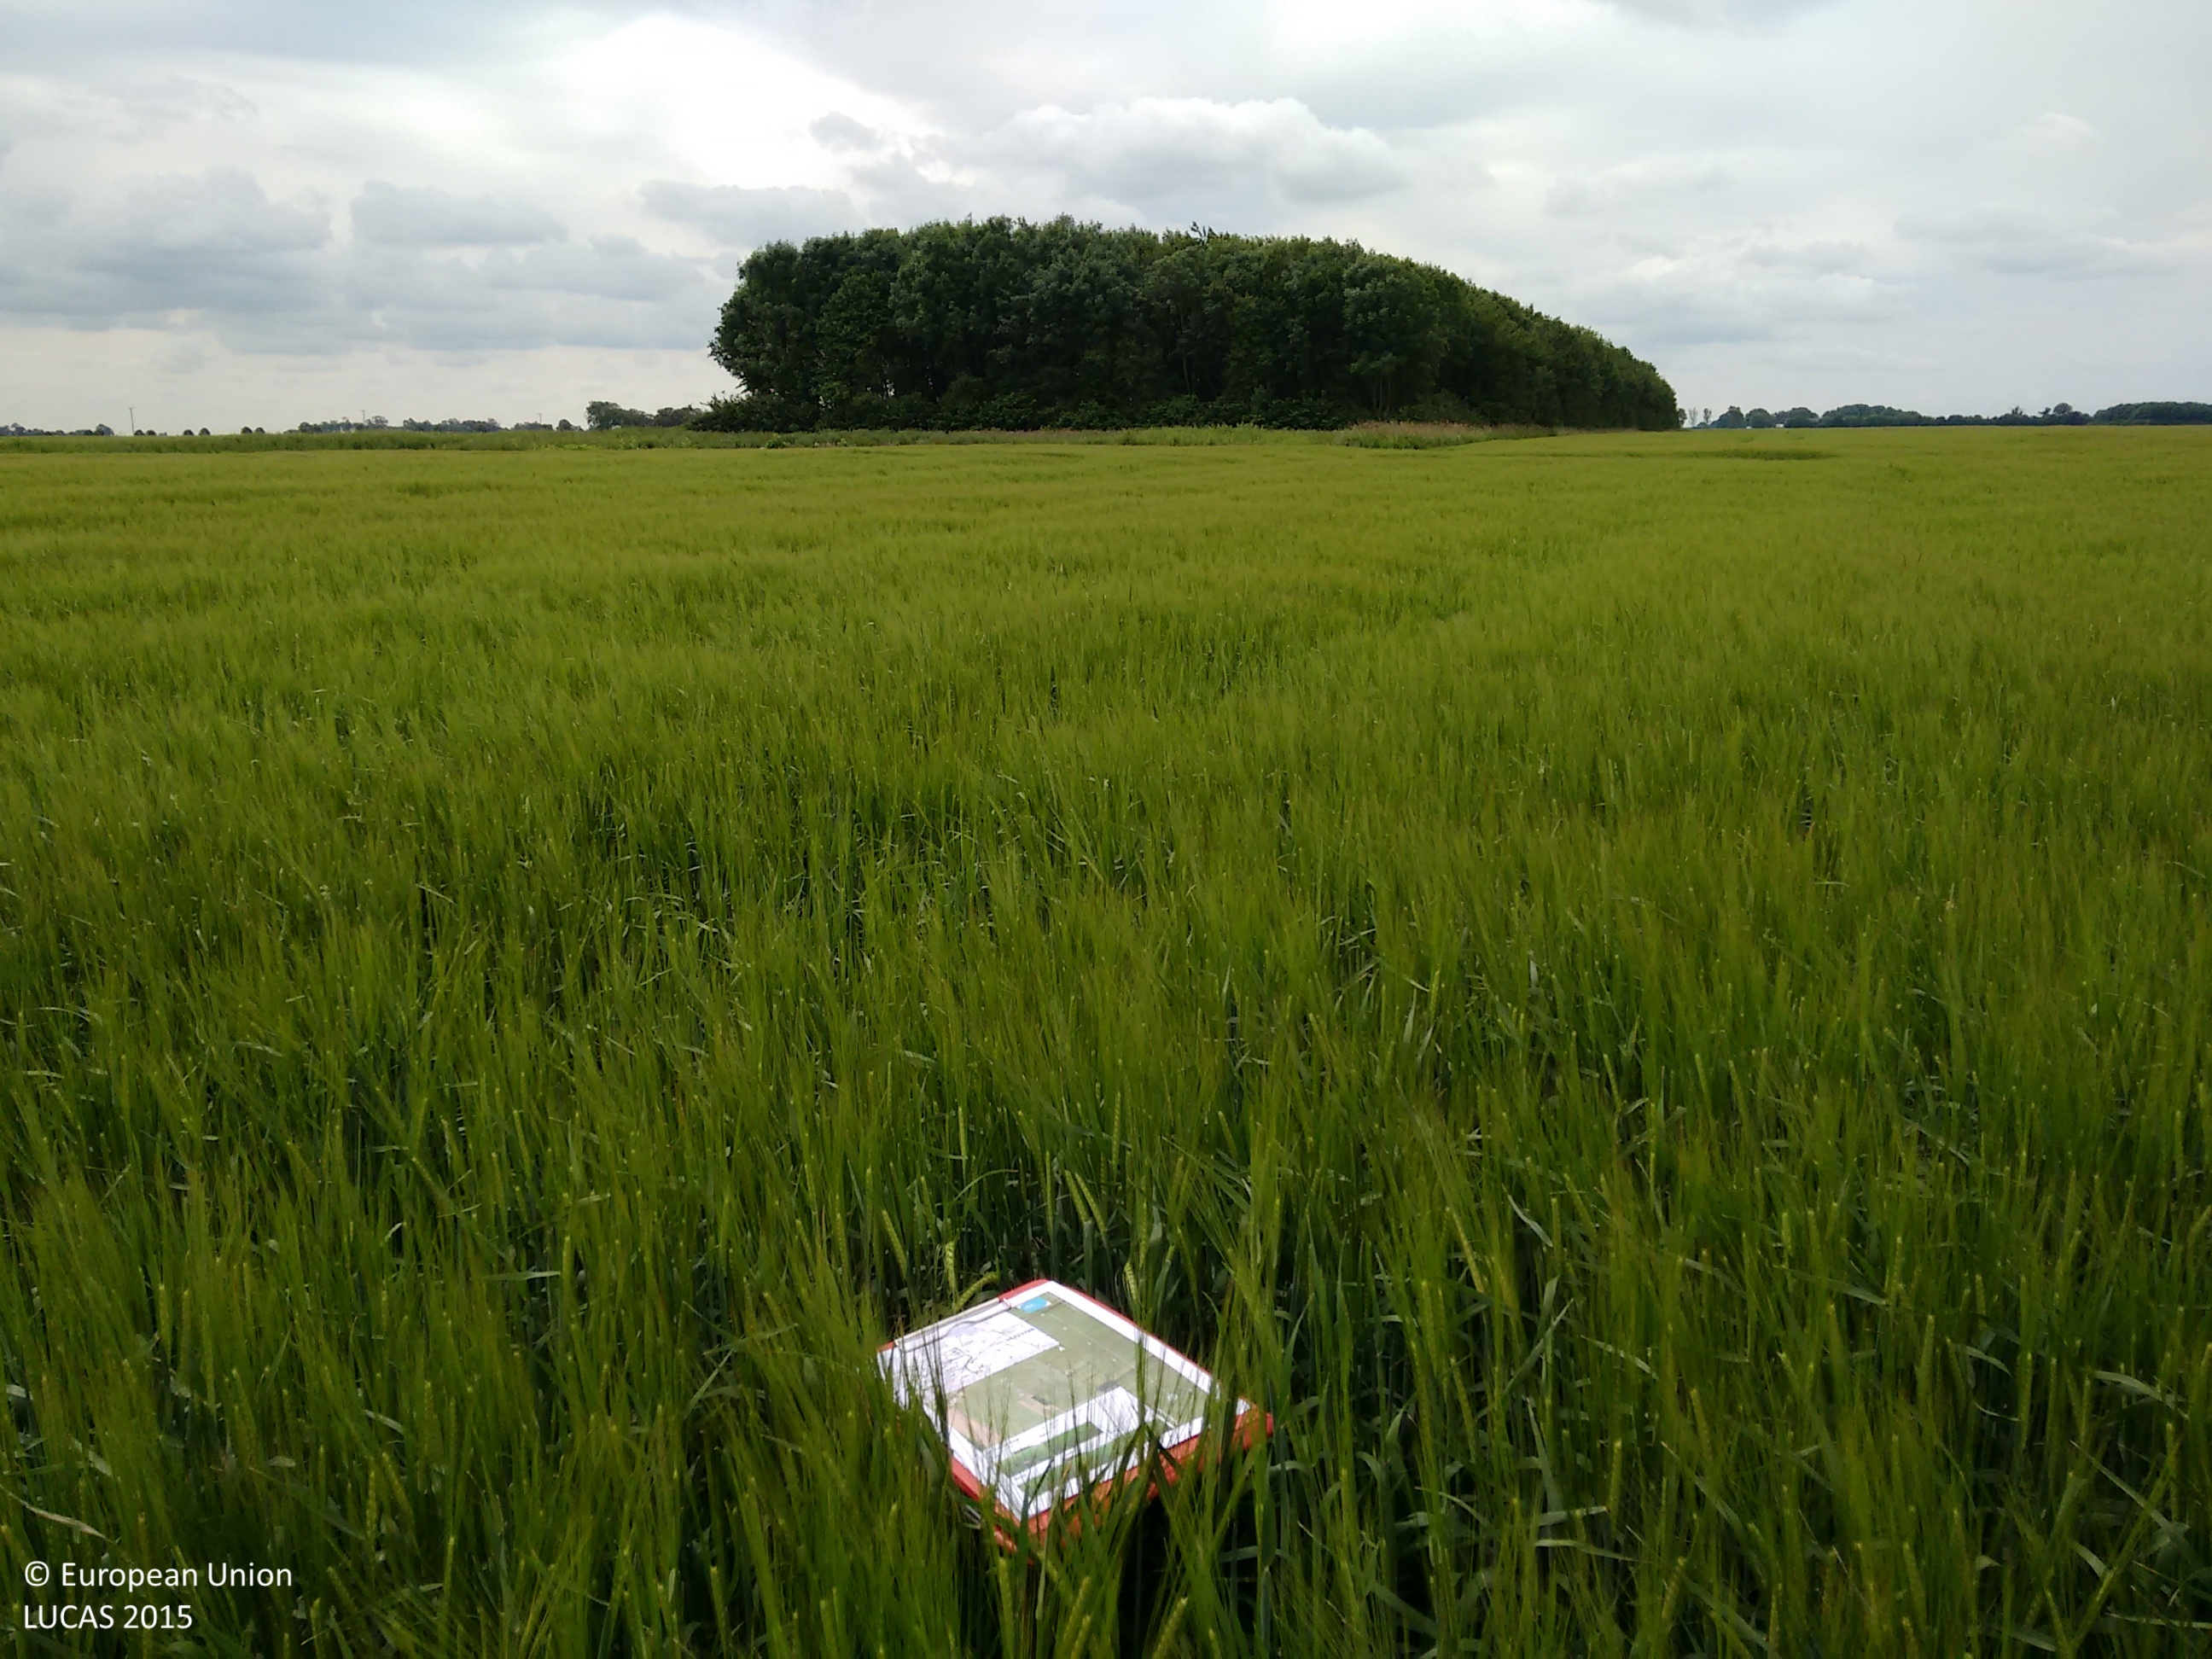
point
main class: Cropland
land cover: Barley
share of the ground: > 75 %
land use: Agriculture (excluding fallow land and kitchen gardens)
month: June
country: GB
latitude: 52.6371
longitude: -0.0666
